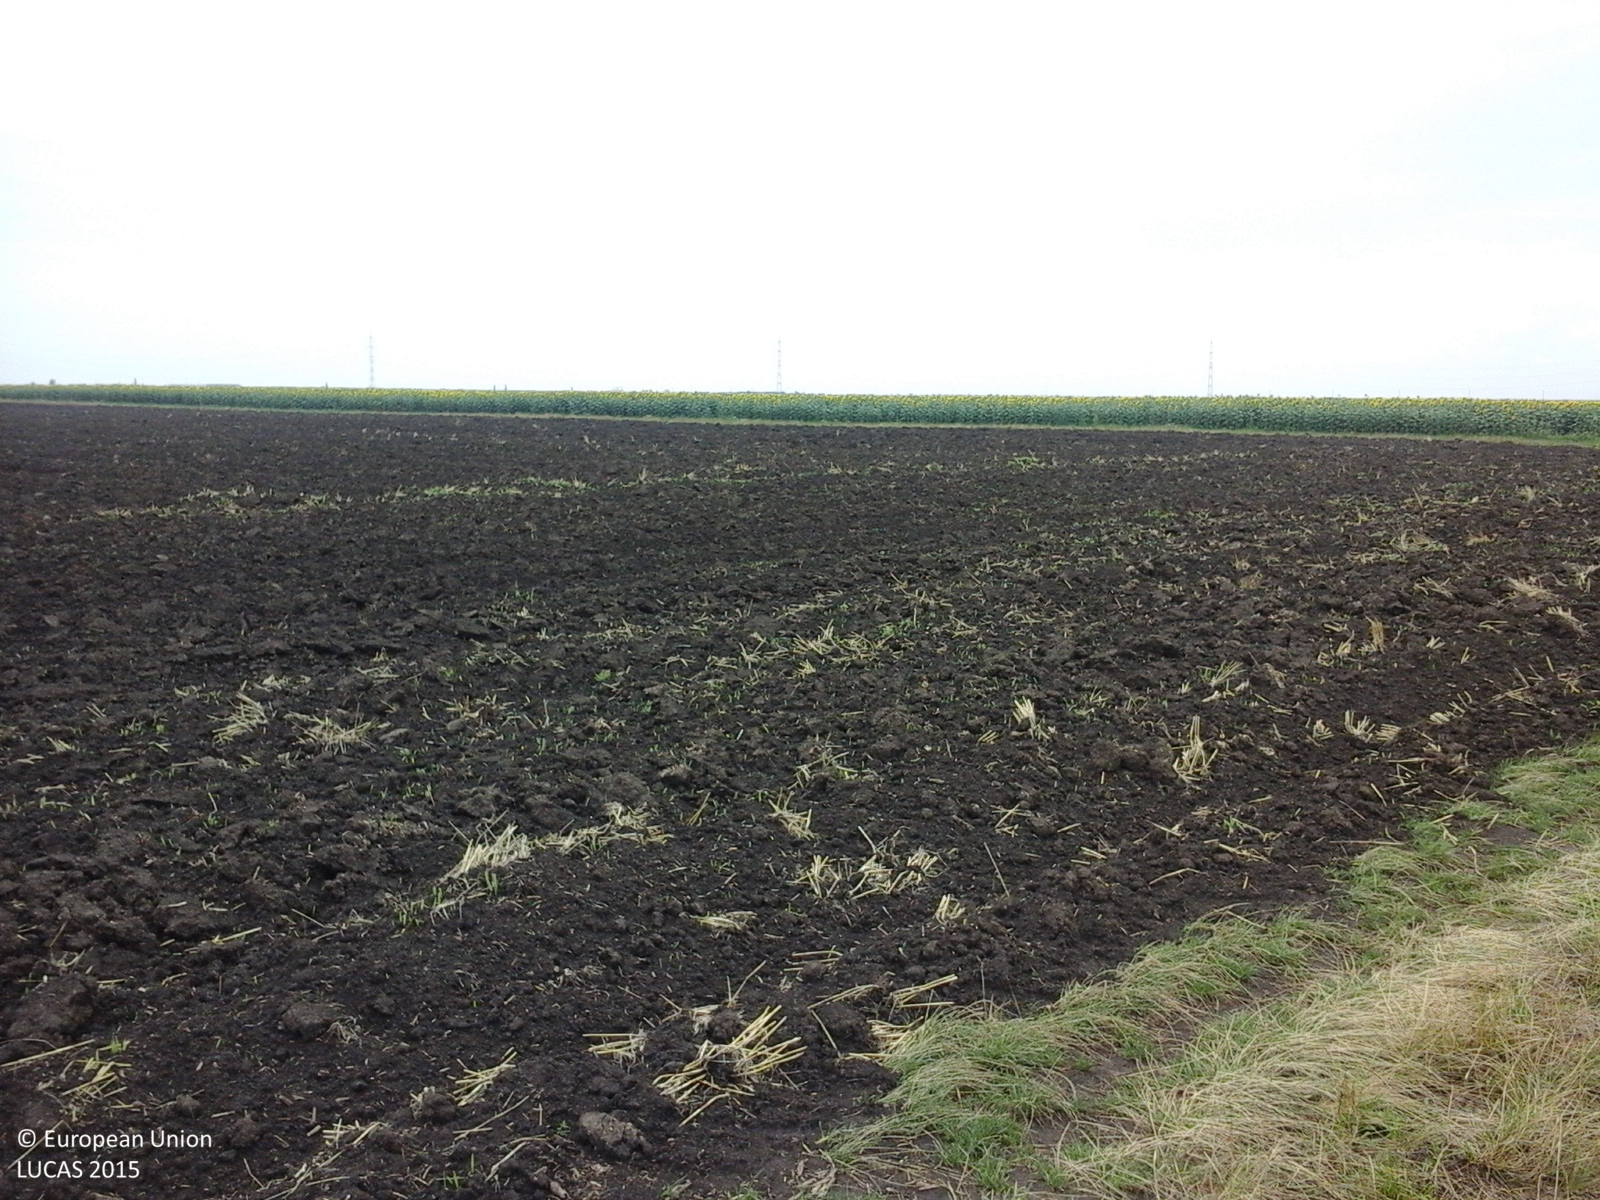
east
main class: Cropland
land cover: Sunflower
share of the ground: > 75 %
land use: Agriculture (excluding fallow land and kitchen gardens)
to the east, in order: Sunflower; Tracks; Common wheat; Tracks; Sunflower
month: July
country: RO
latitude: 44.0007
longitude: 25.8710
